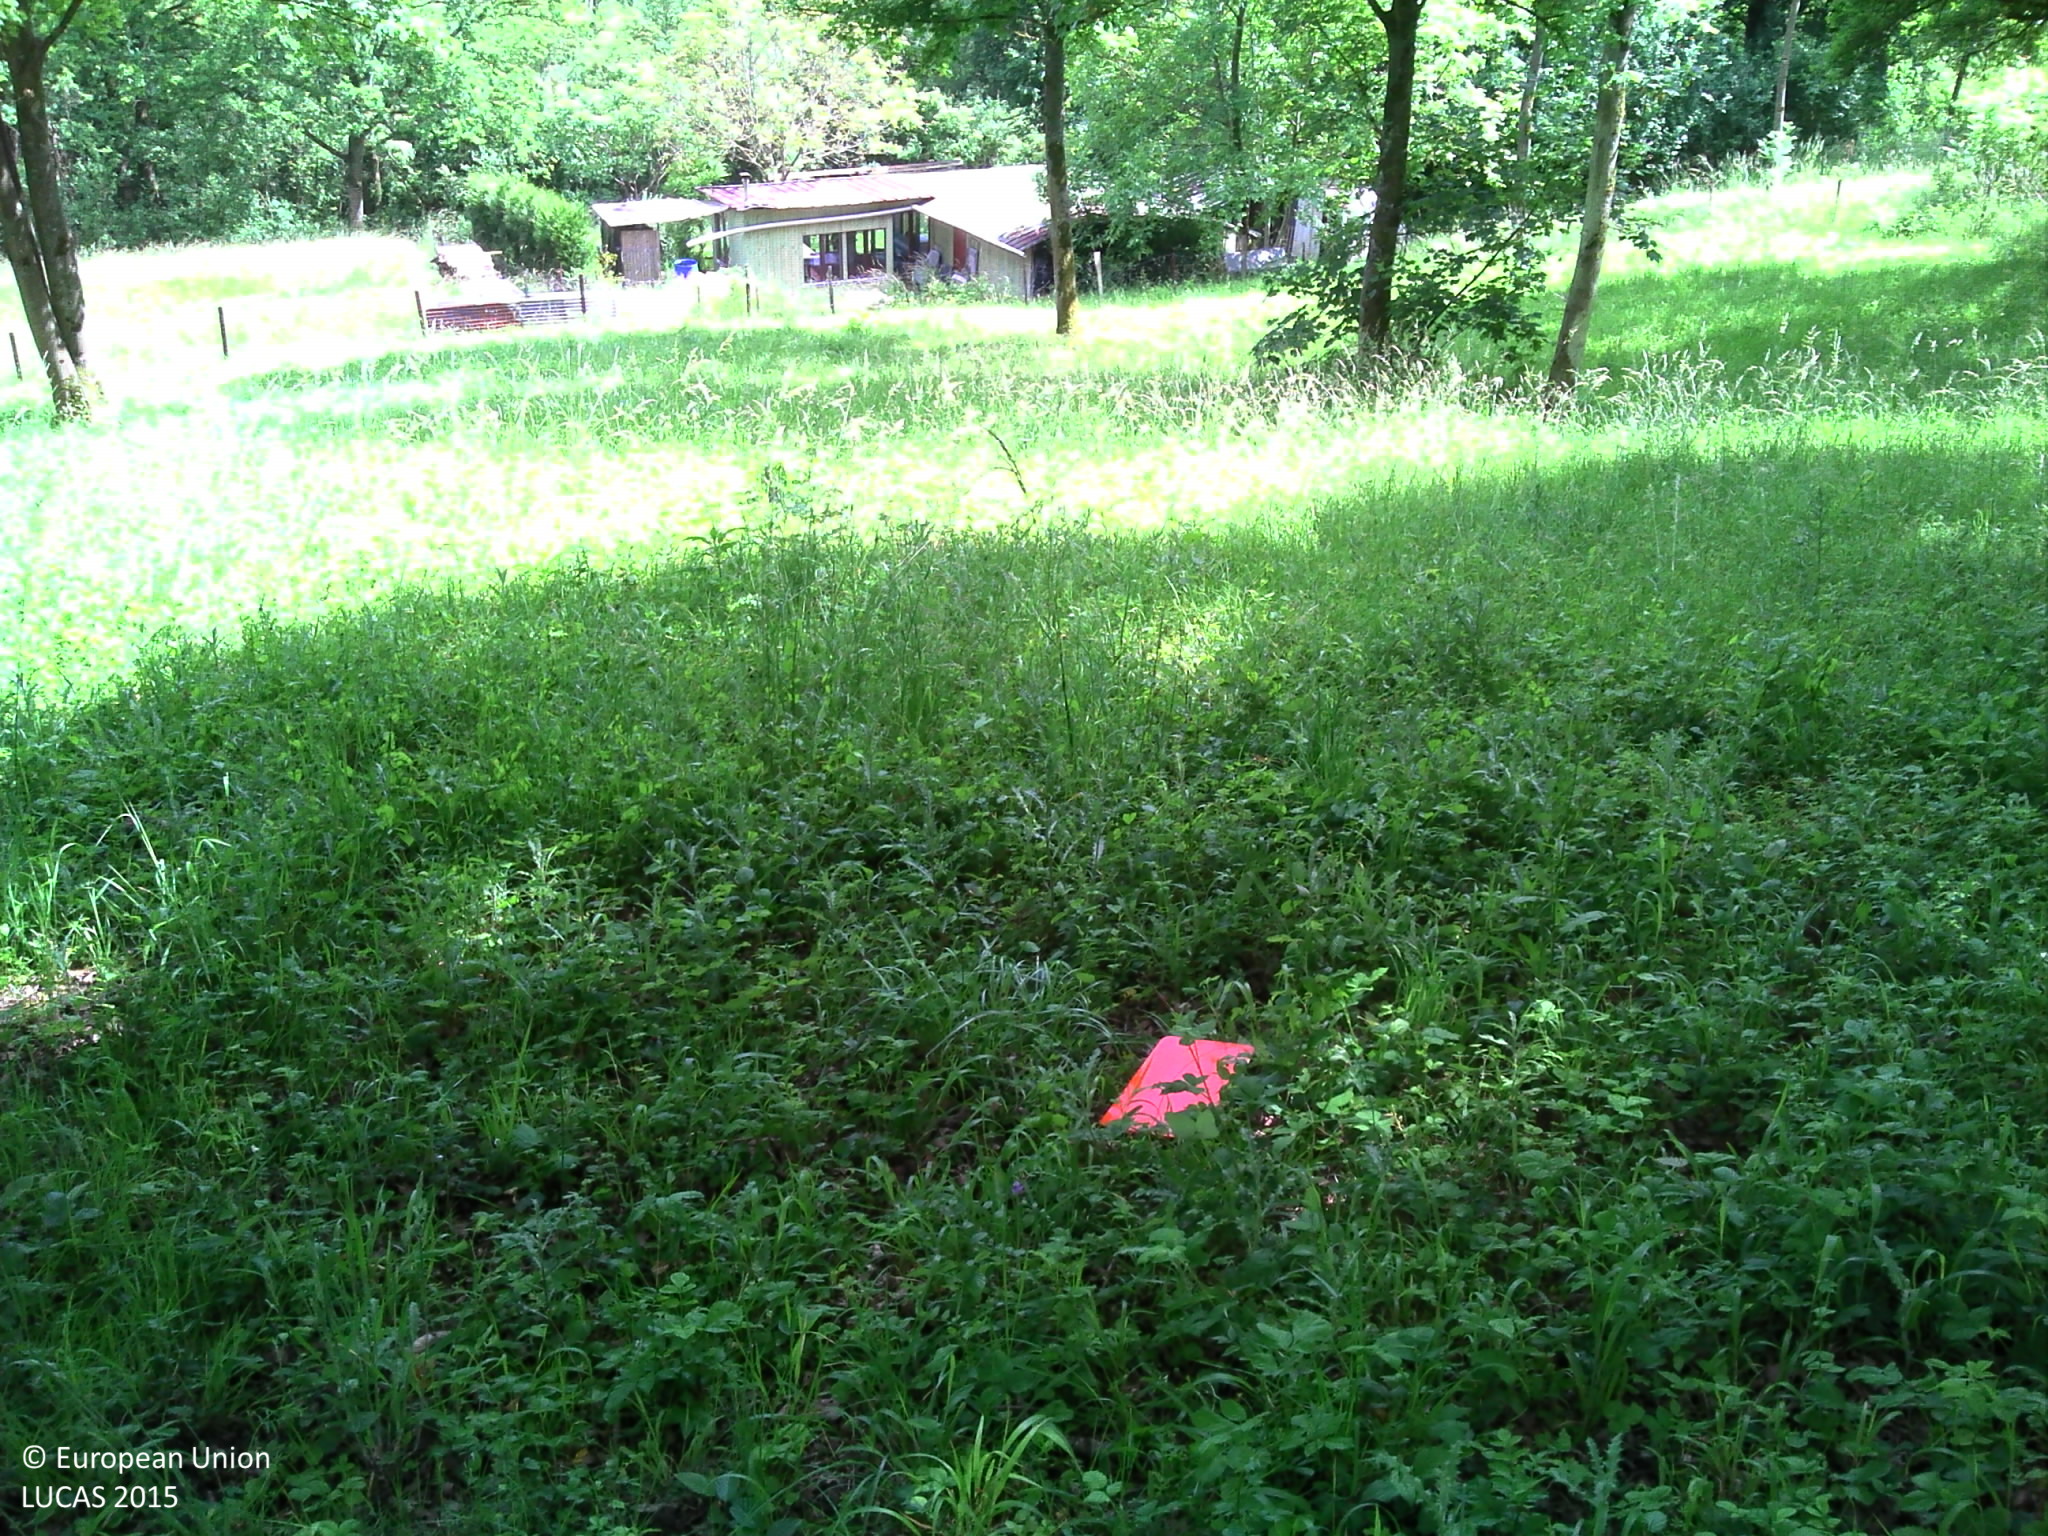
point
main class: Woodland
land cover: Broadleaved woodland
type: mesophytic deciduous forest
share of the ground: > 75 %
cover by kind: broadleaved forest trees 50 %, herbaceous plants 50 %
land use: Agriculture (excluding fallow land and kitchen gardens)
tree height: > 5 m
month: June
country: FR
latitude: 48.6476
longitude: 6.2947
